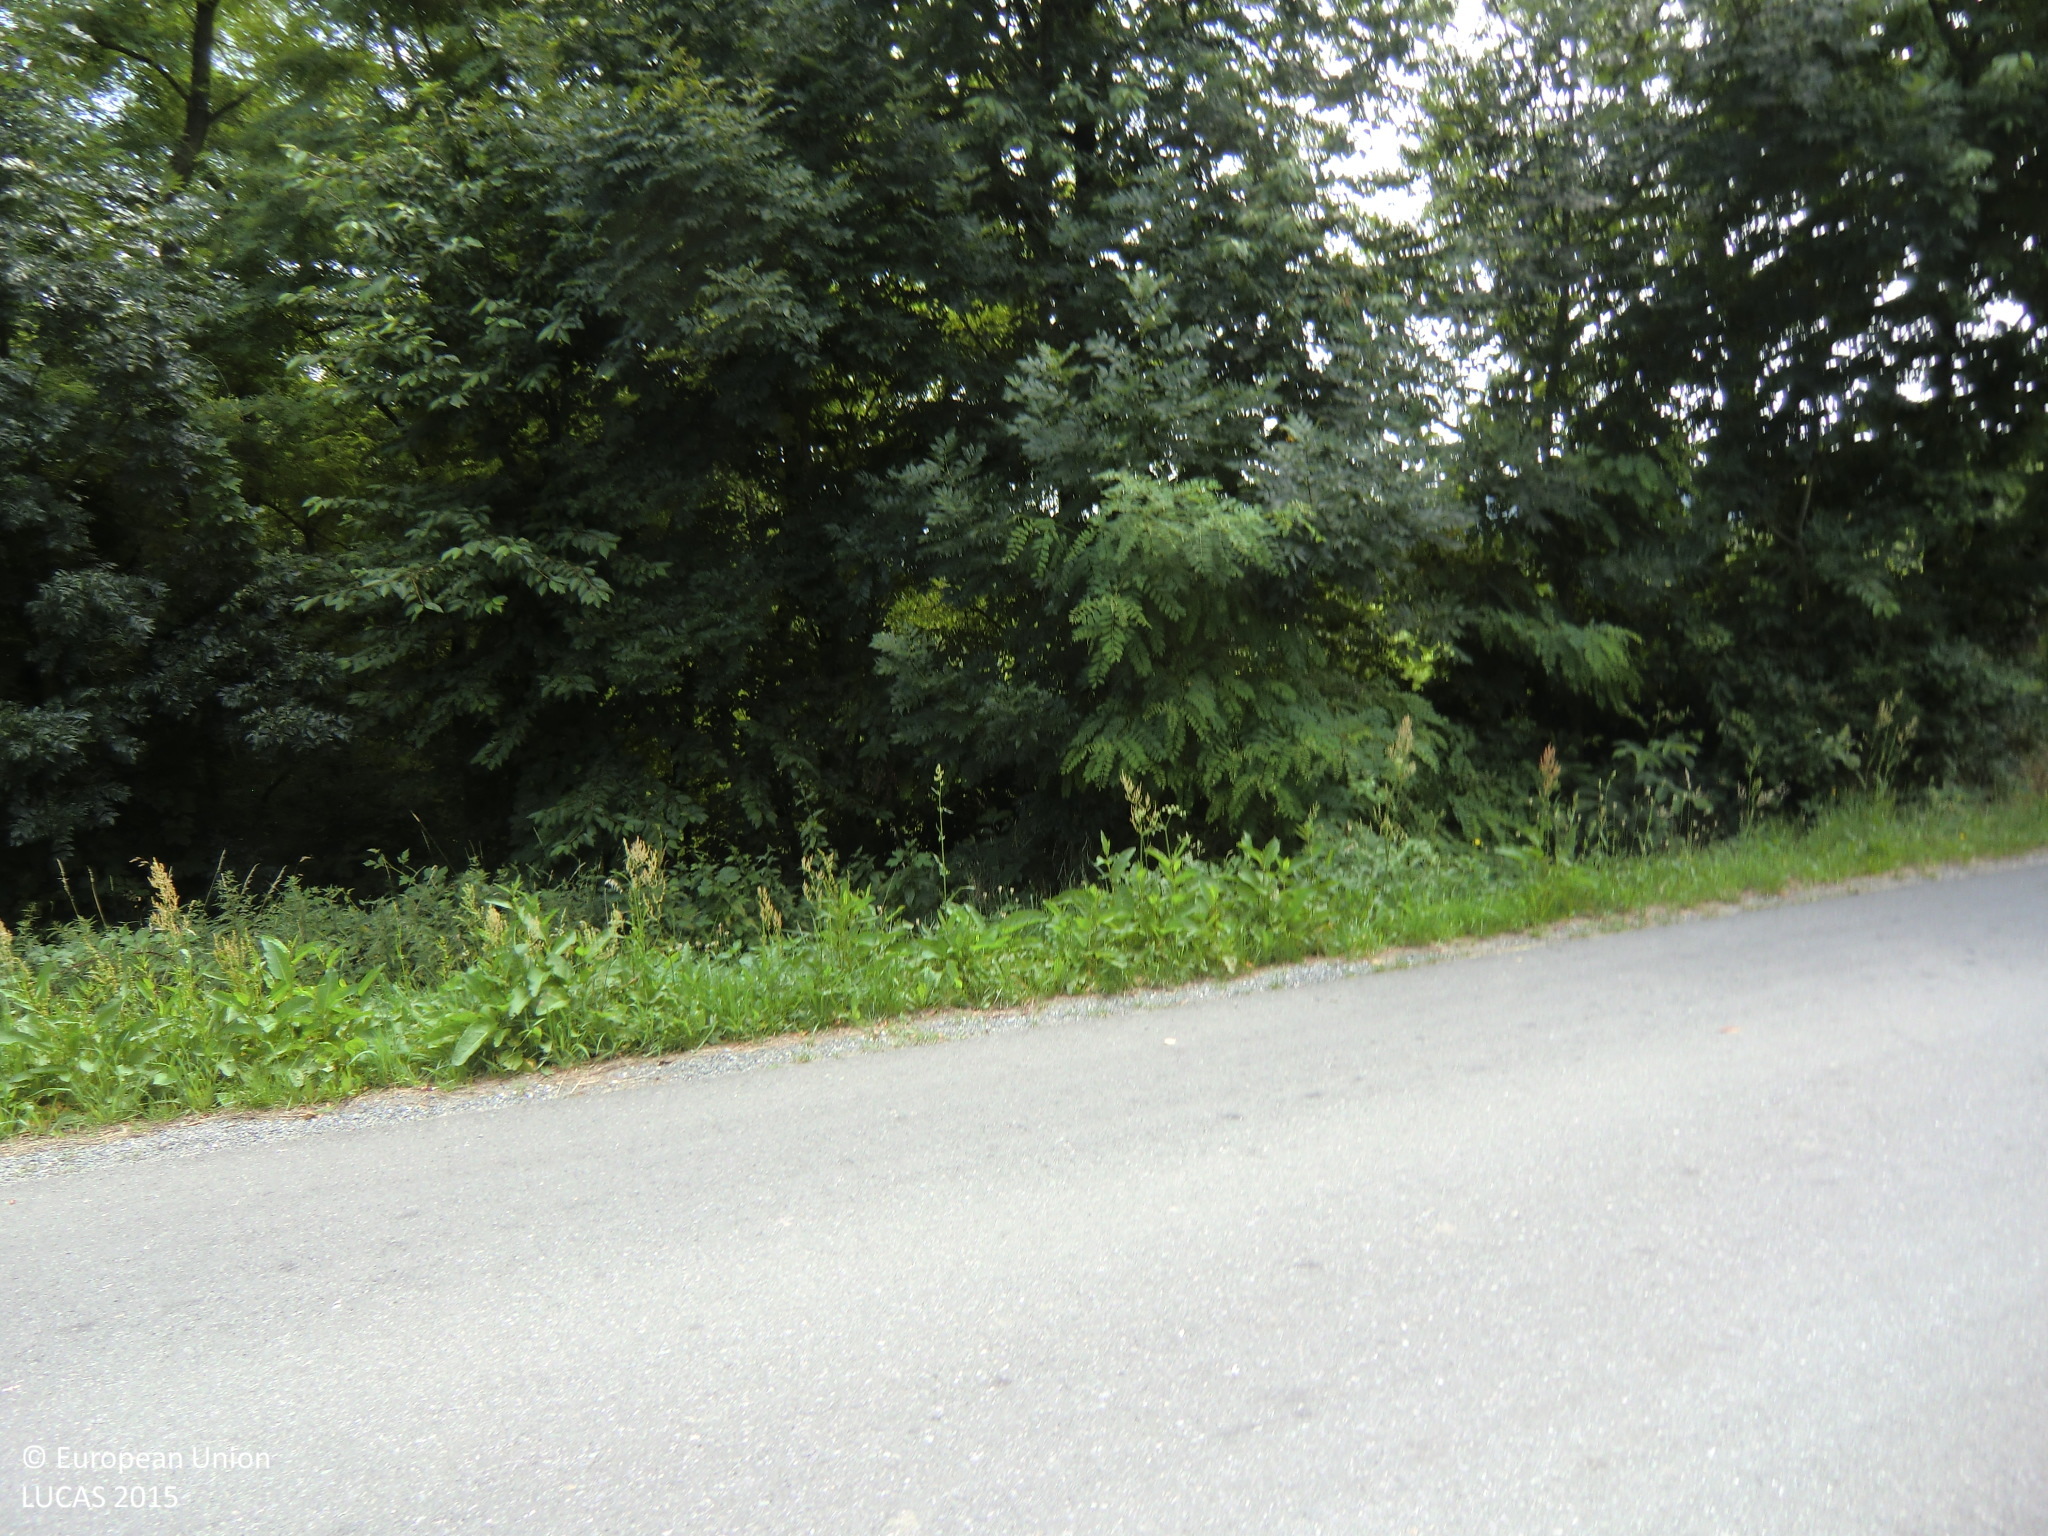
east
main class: Grassland
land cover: Grassland with sparse tree/shrub cover
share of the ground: > 75 %
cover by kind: herbaceous plants 95 %, broadleaved forest trees 5 %
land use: Residential
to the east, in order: Grassland with sparse tree/shrub cover; Conifer hedges; Grassland without tree/shrub cover; Paved roads, cycling and walking lanes; Grass margins; Spruce dominated mixed woodland; Tracks; Spruce dominated coniferous woodland; Broadleaved woodland; Soya
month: July
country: AT
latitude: 47.0785
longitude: 16.1258
